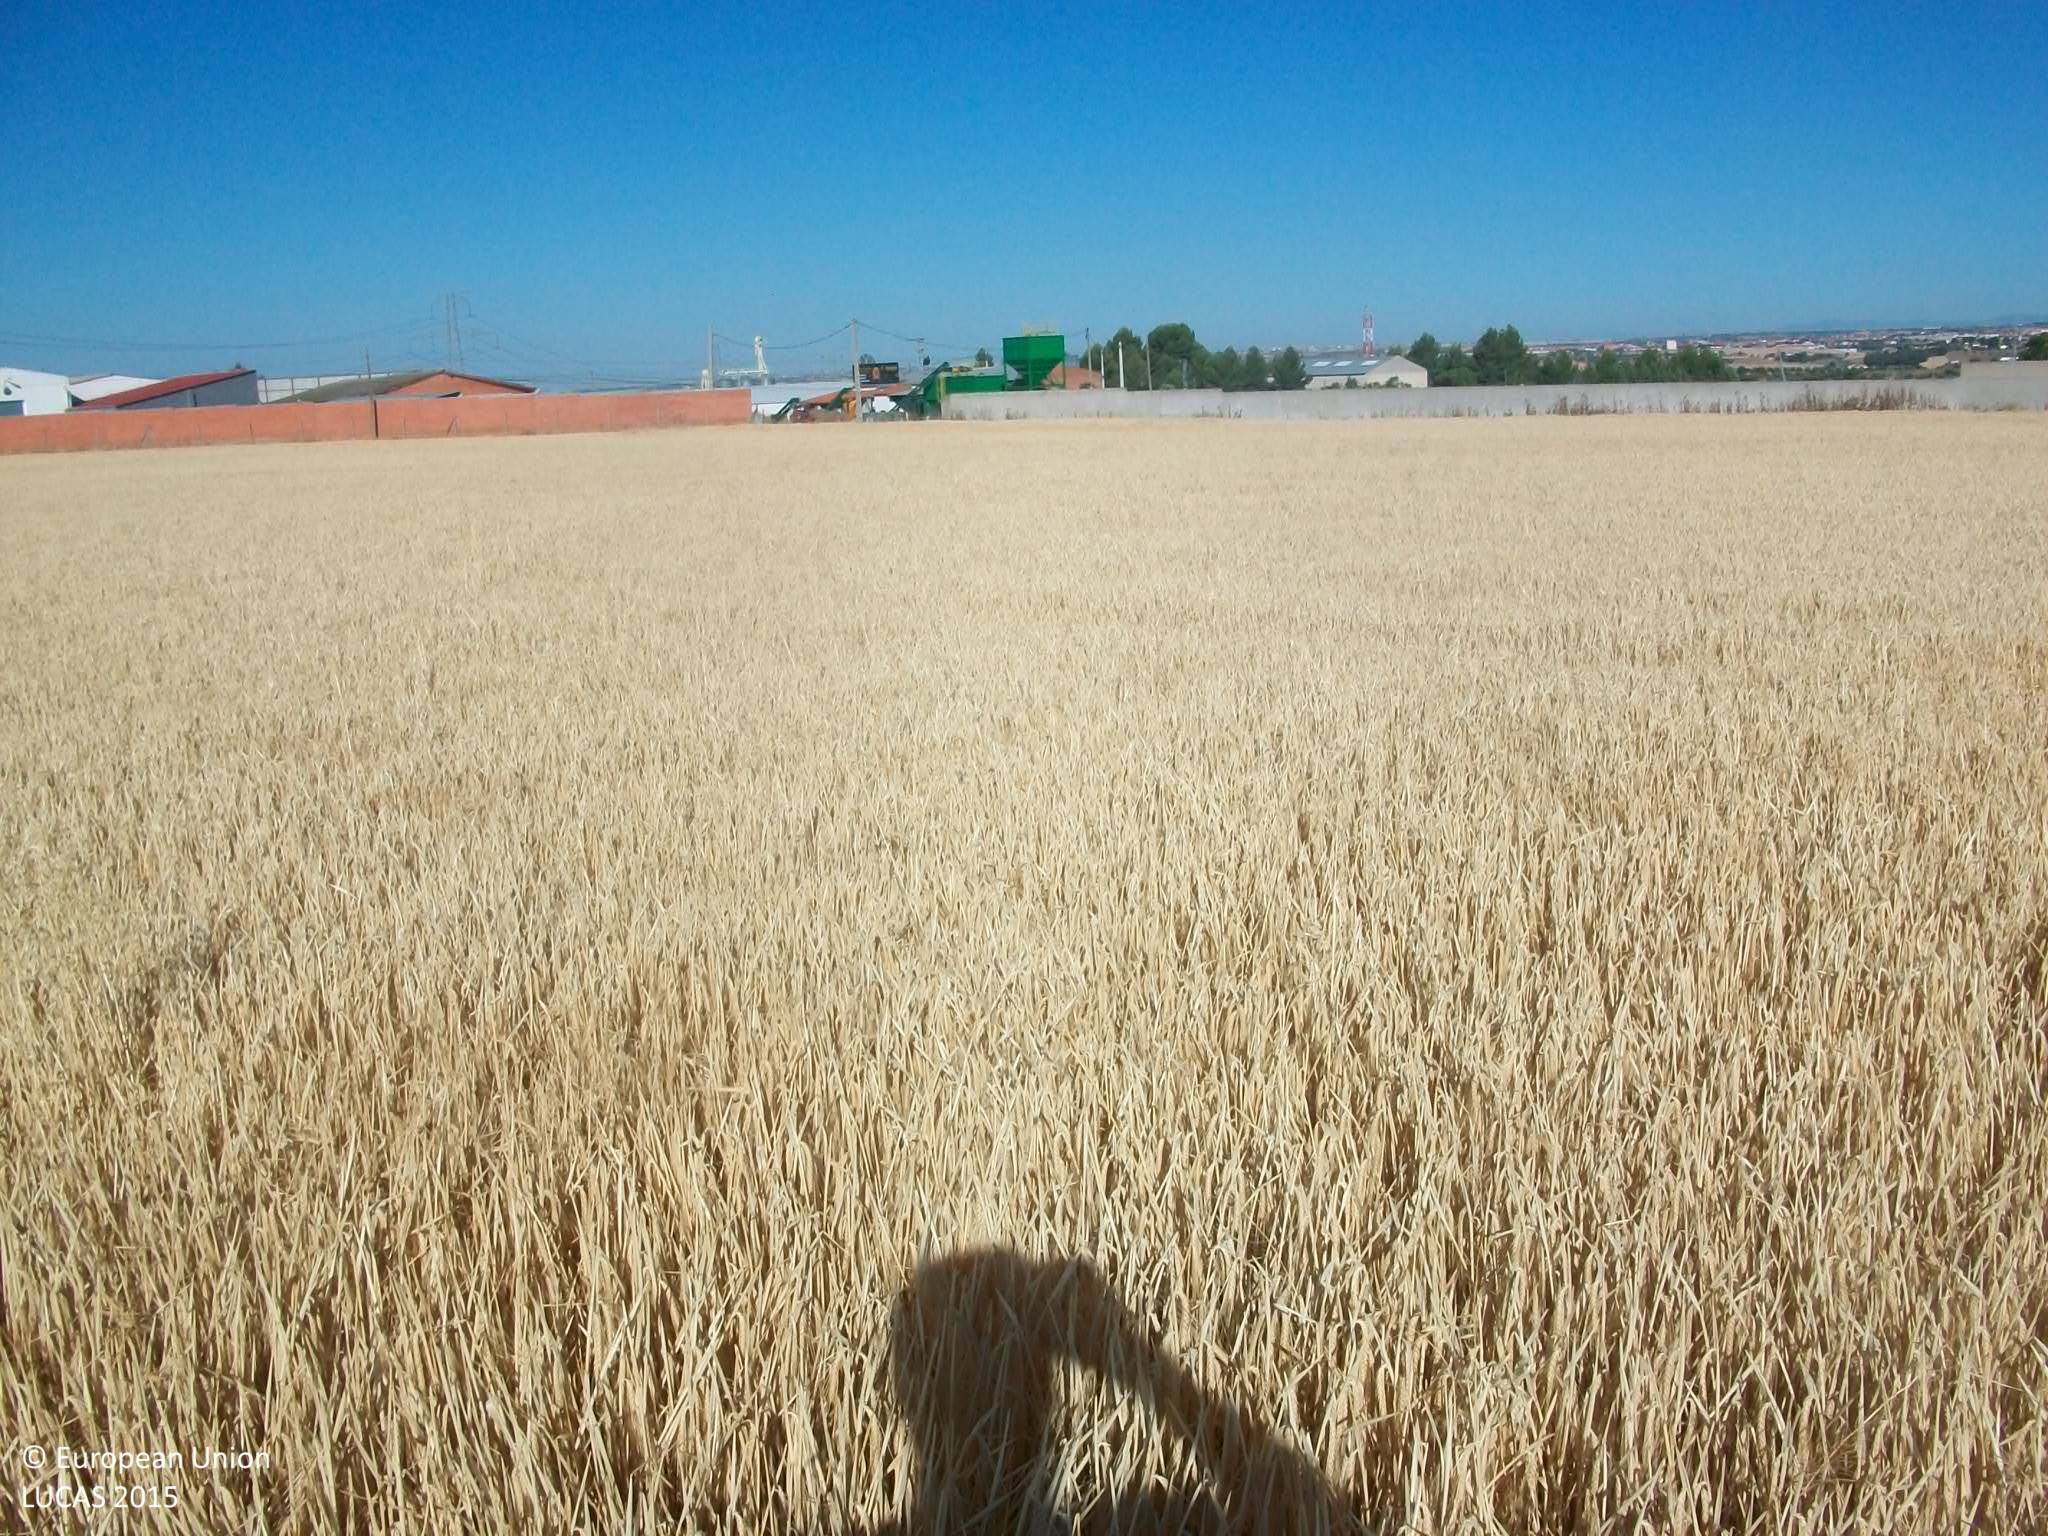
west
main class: Cropland
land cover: Barley
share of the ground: > 75 %
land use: Agriculture (excluding fallow land and kitchen gardens)
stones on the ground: < 10 %
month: June
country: ES
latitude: 40.1153
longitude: -3.7739
